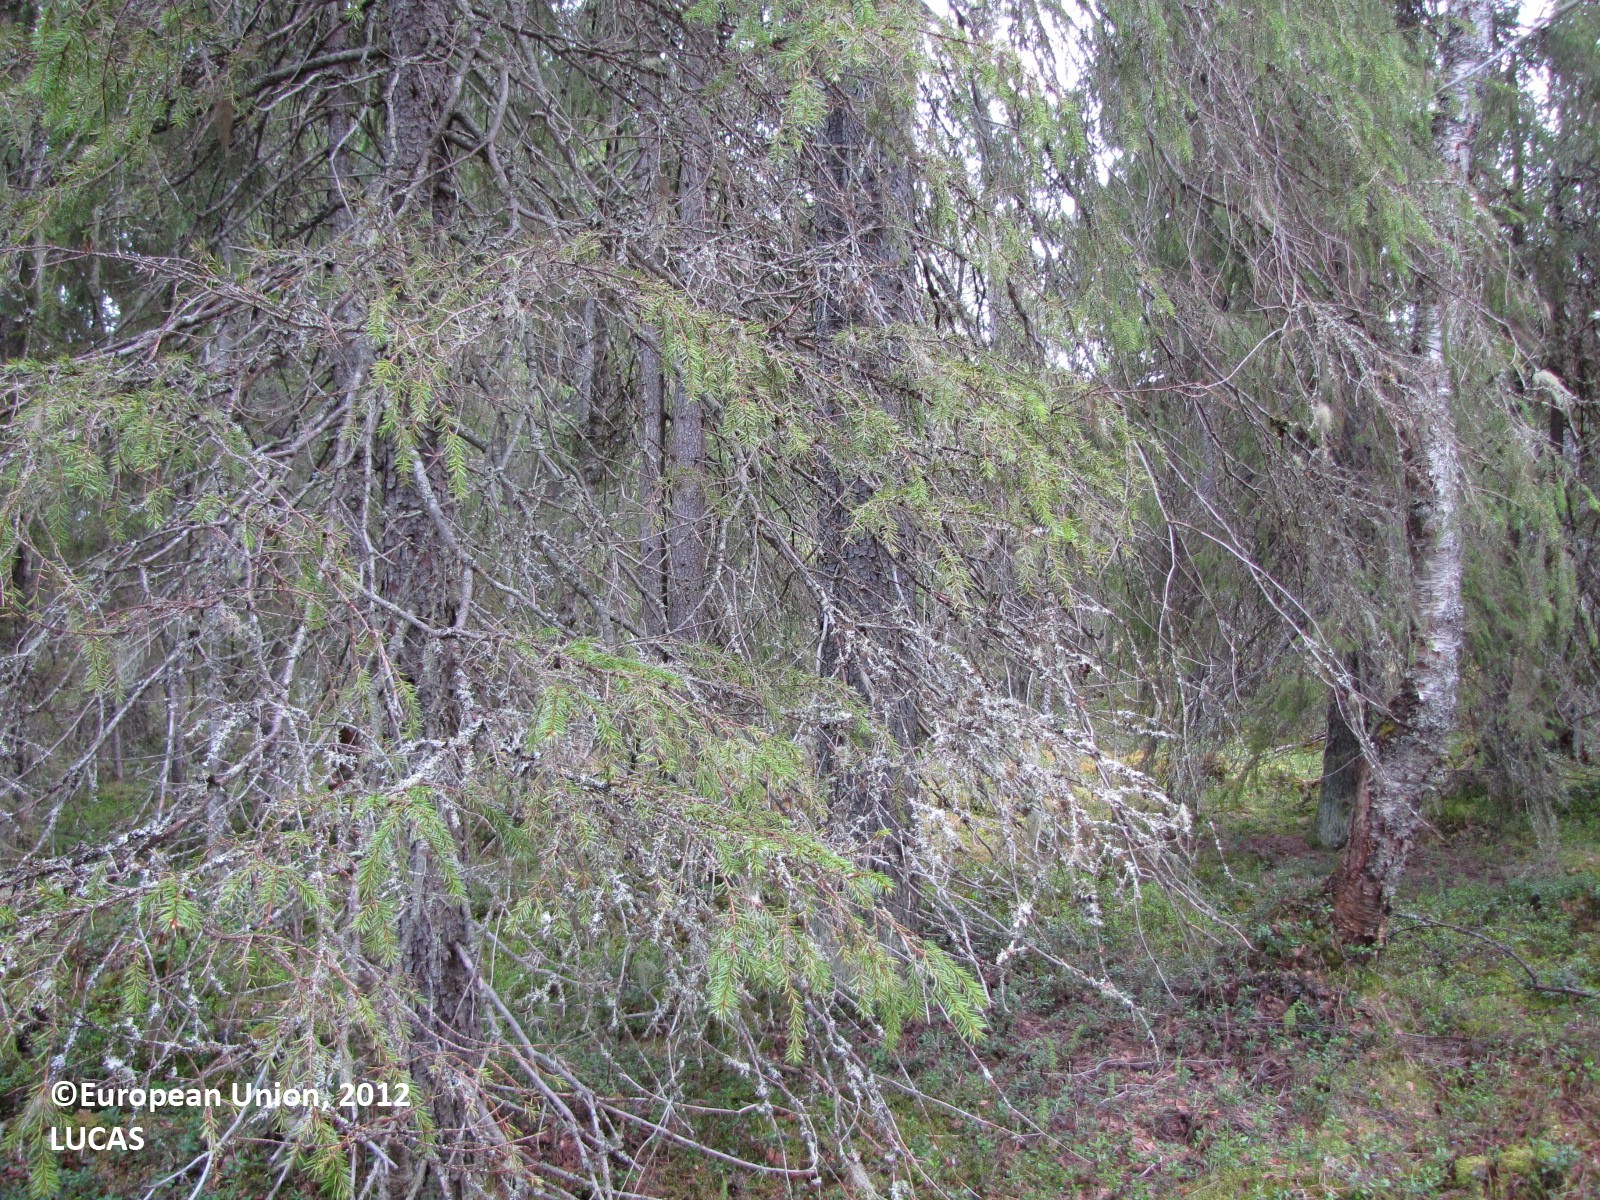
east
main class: Woodland
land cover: Spruce dominated coniferous woodland
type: boreal forest
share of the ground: 50 - 75 %
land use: Forestry
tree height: > 5 m
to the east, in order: Spruce dominated coniferous woodland; Ditches and canals; Spruce dominated mixed woodland; Ditches and canals; Spruce dominated mixed woodland; Ditches and canals; Spruce dominated coniferous woodland
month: June
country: FI
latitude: 65.9324
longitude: 24.1764
